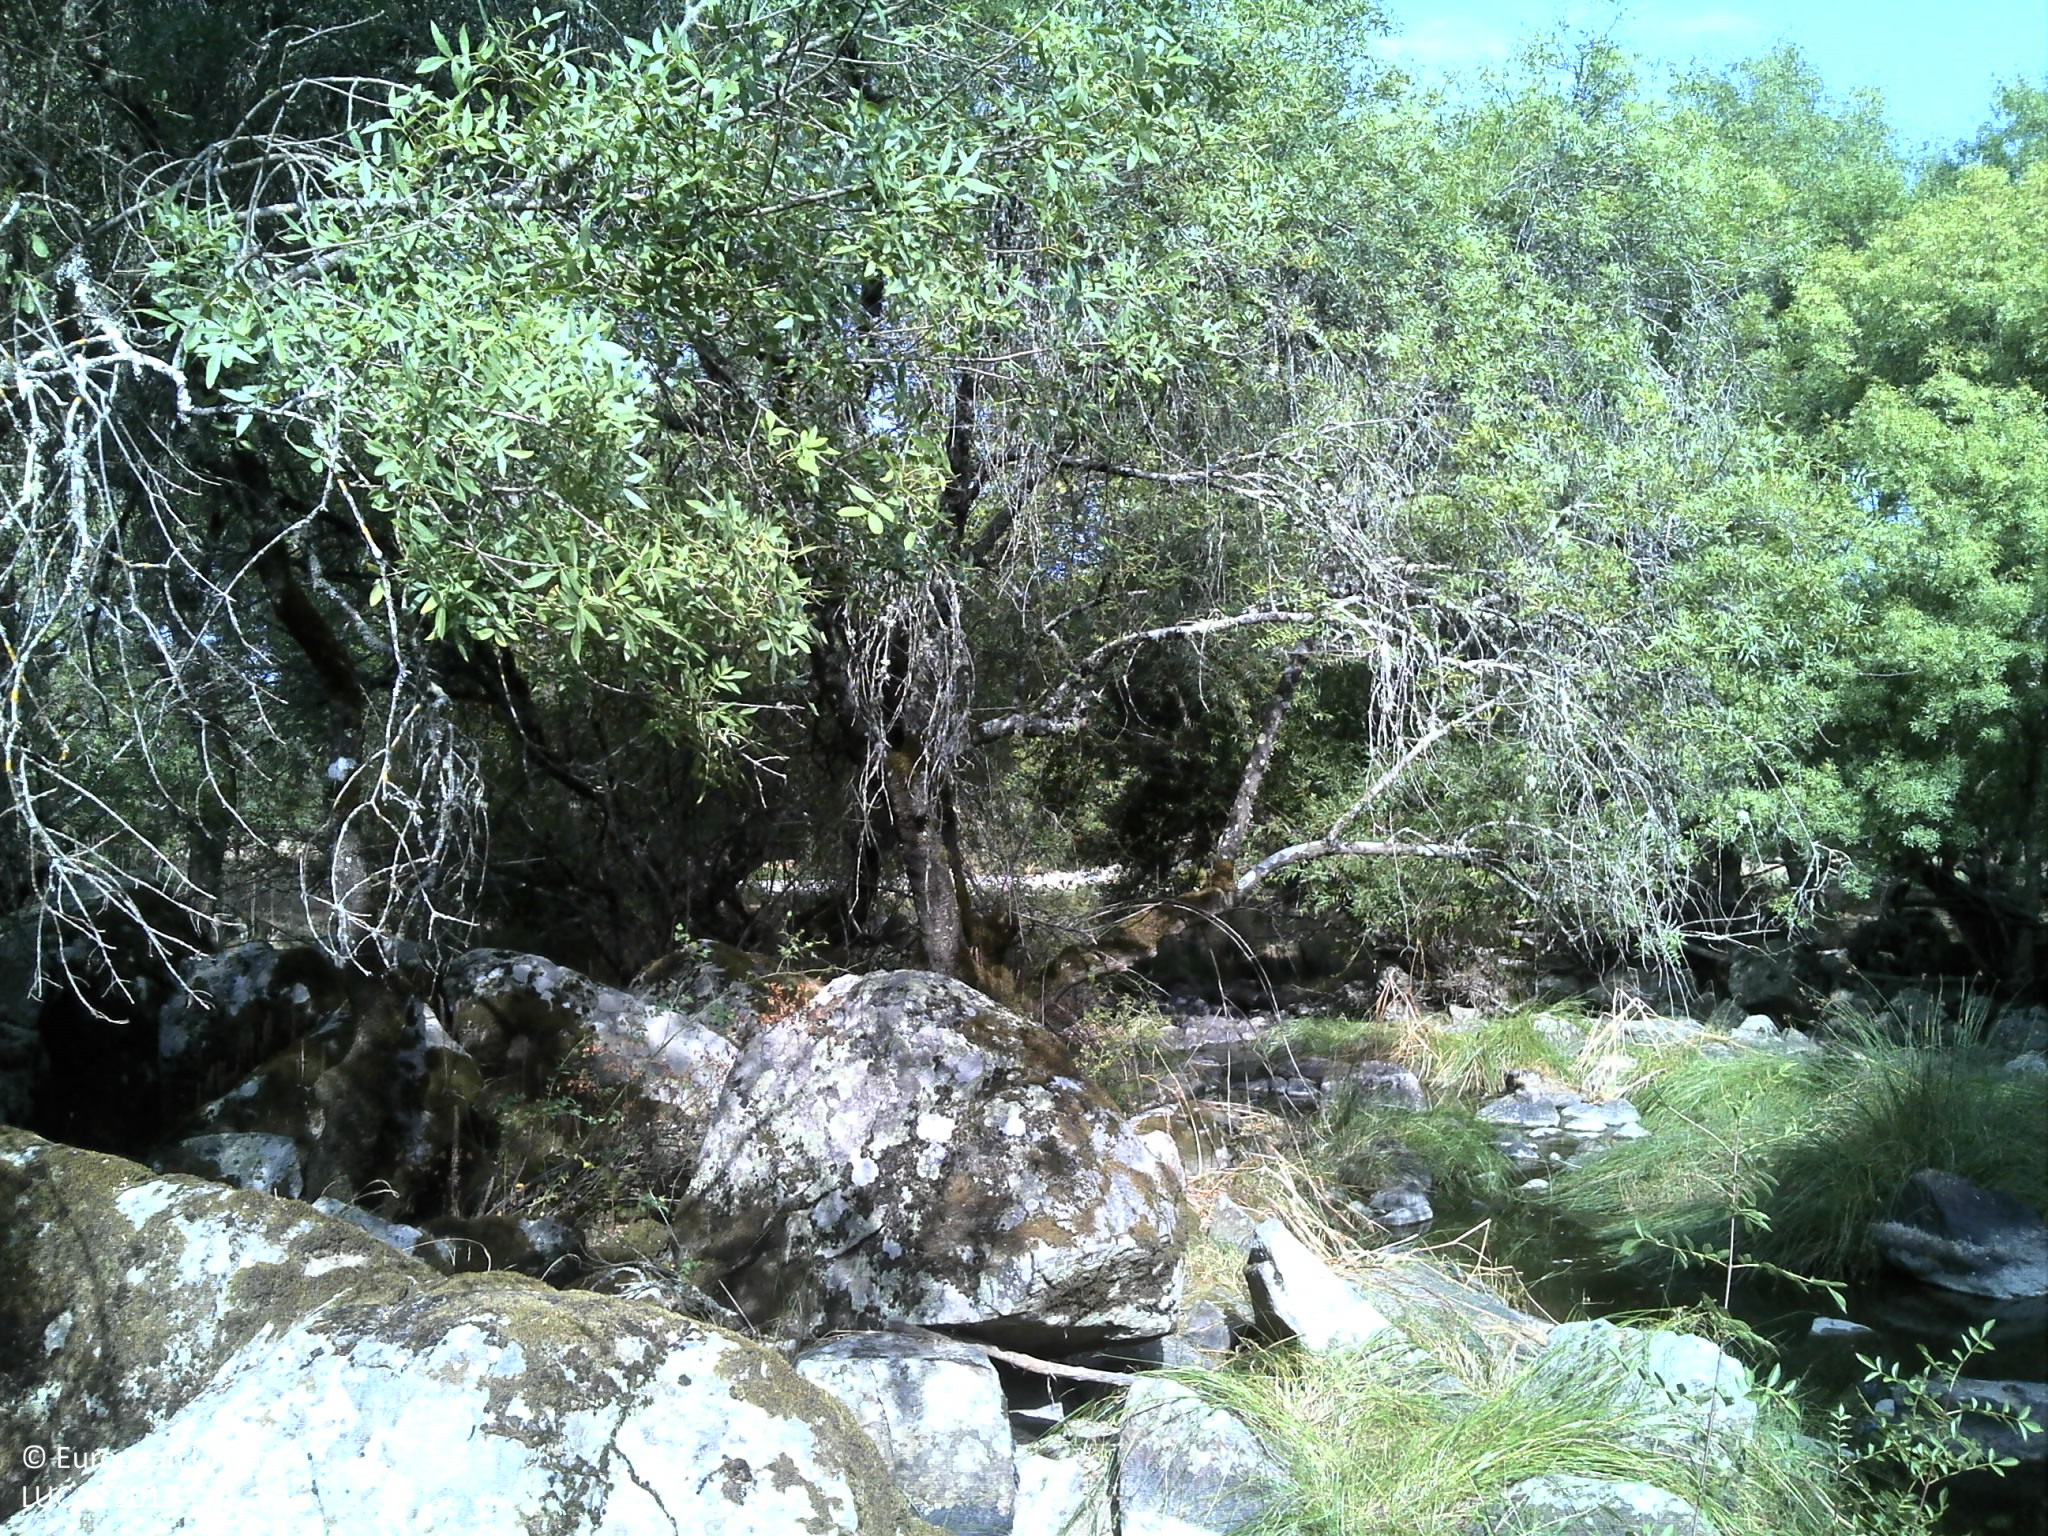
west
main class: Woodland
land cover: Broadleaved woodland
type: broadleaved evergreen forest
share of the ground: > 75 %
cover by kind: broadleaved forest trees 75 %, consolidated bare surface 25 %
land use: Forestry
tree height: > 5 m
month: August
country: PT
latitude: 39.2612
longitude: -7.5555
